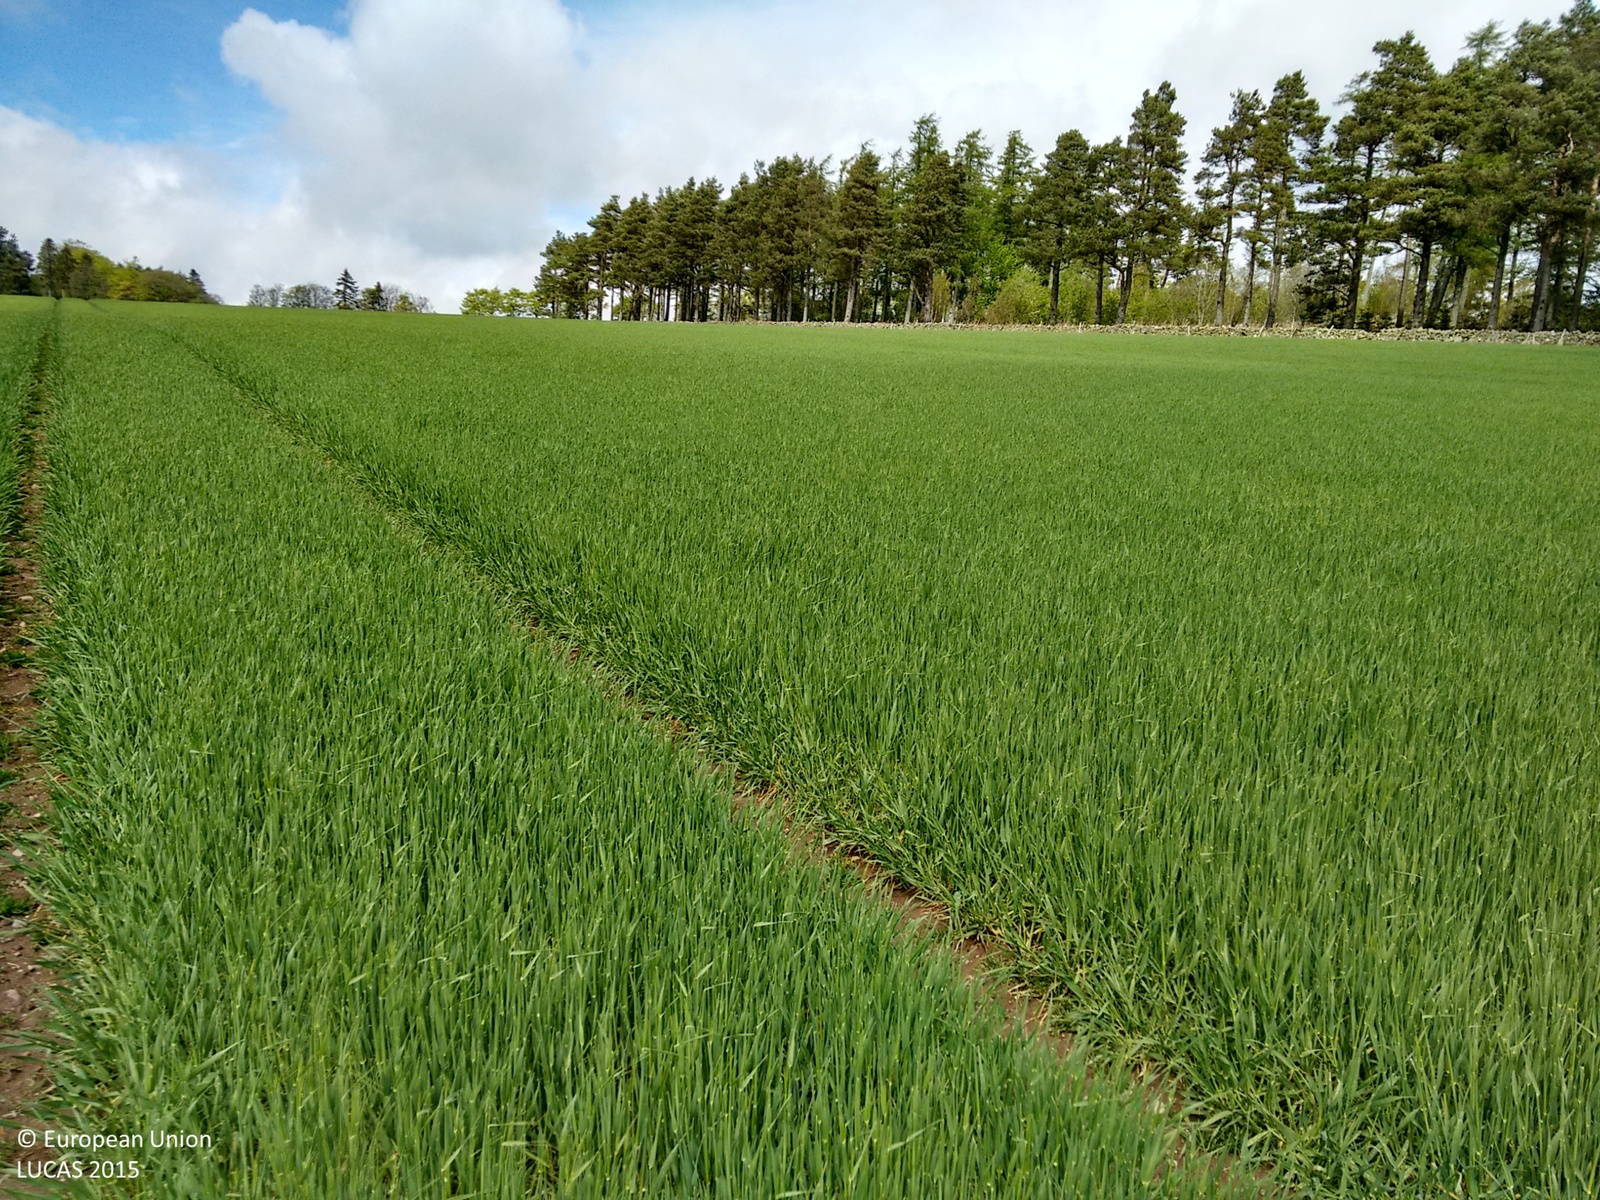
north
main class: Cropland
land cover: Barley
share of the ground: > 75 %
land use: Agriculture (excluding fallow land and kitchen gardens)
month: May
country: GB
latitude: 55.8466
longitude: -2.5016
